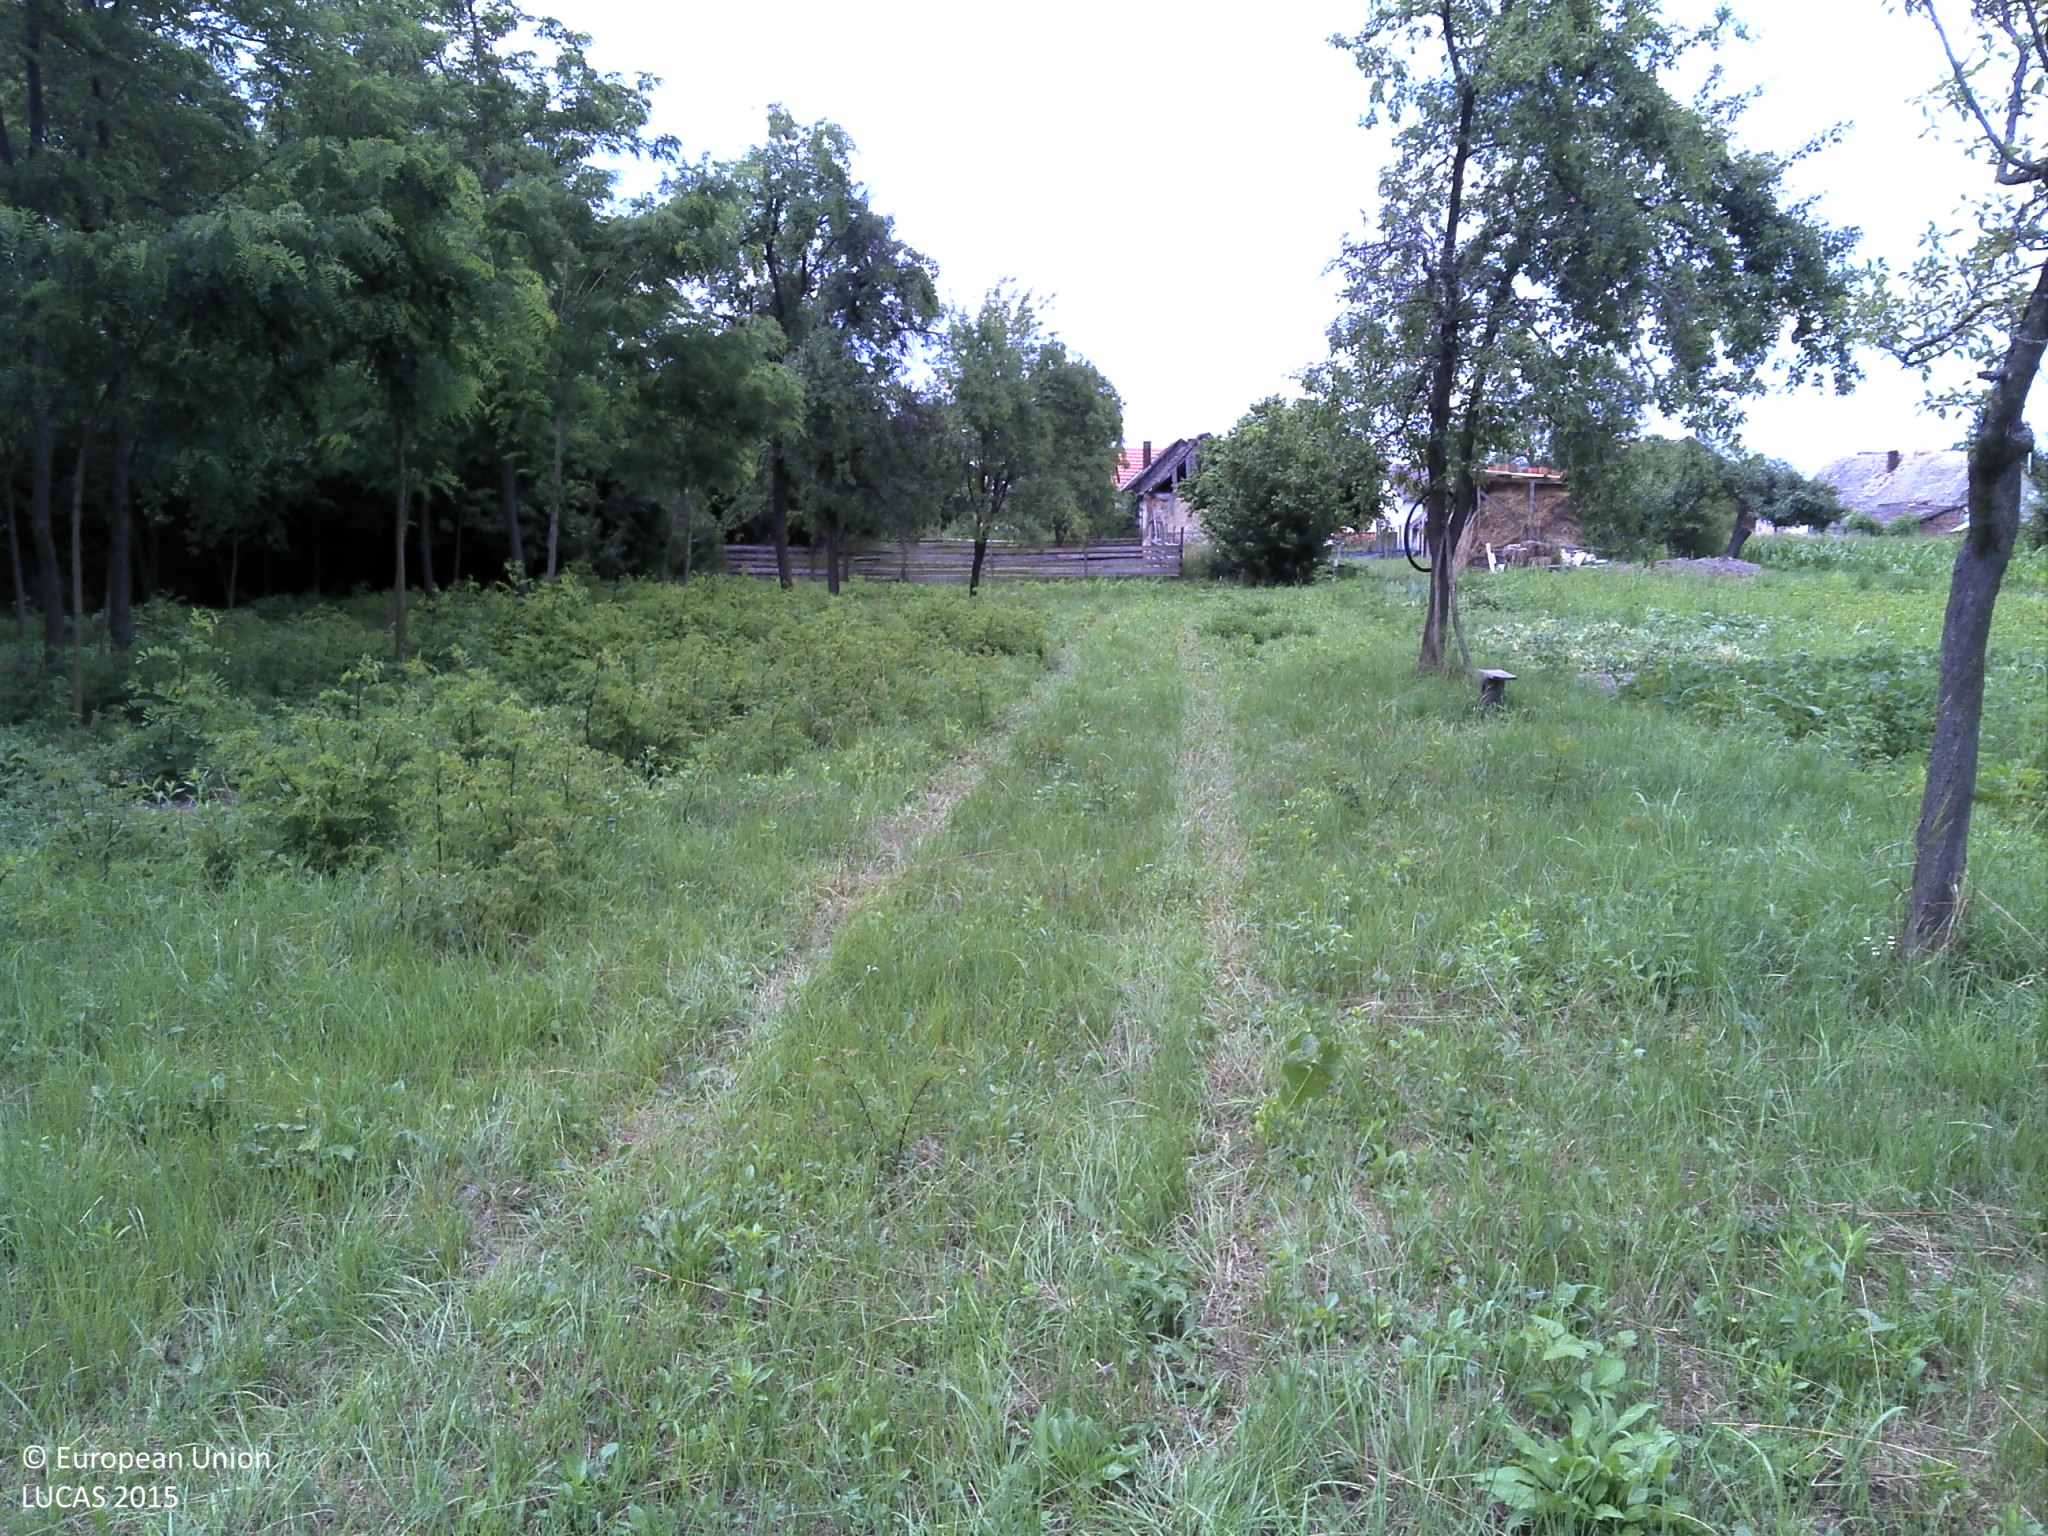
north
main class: Grassland
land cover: Grassland with sparse tree/shrub cover
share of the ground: > 75 %
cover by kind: herbaceous plants 90 %, broadleaved forest trees 5 %, shrubs 5 %
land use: Semi-natural and natural areas not in use
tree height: < 5 m
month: June
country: HR
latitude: 45.6912
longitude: 18.2111
